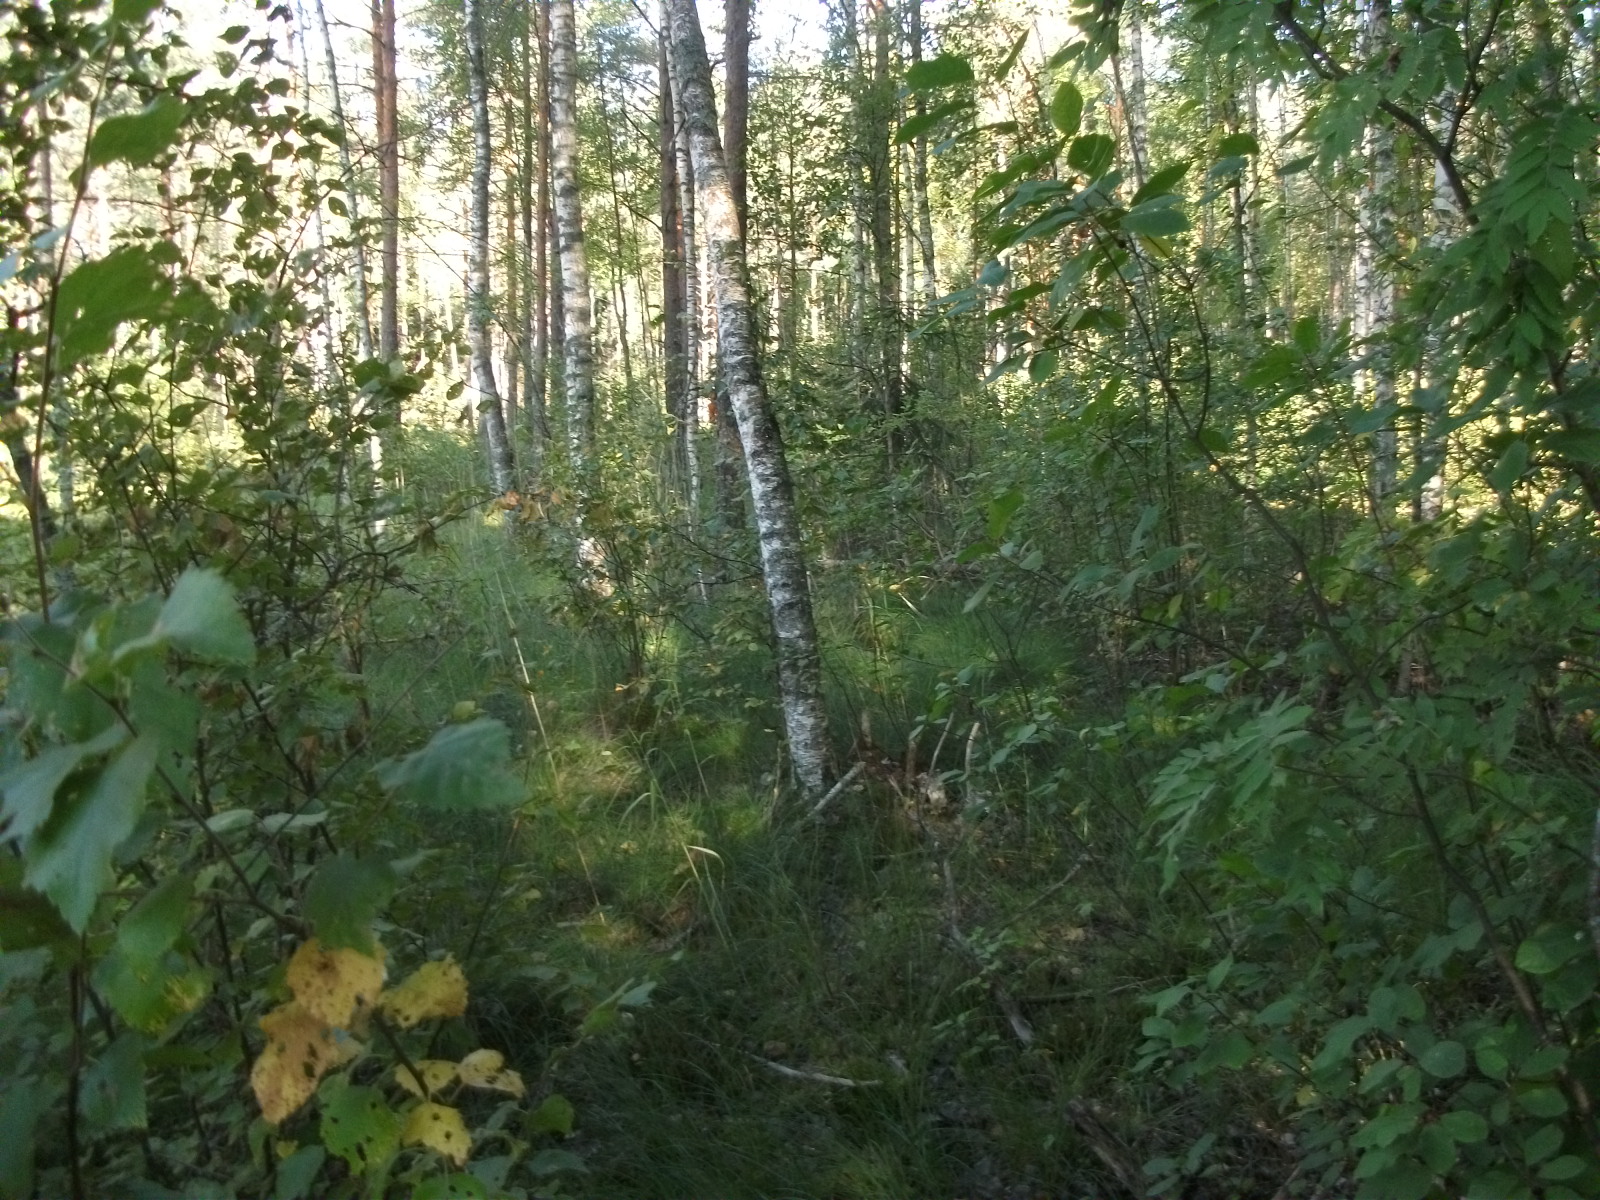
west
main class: Woodland
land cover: Broadleaved woodland
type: non-riverine alder, birch or aspen forest
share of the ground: > 75 %
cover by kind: broadleaved forest trees 85 %, shrubs 10 %, coniferous forest trees 5 %
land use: Forestry
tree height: > 5 m
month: August
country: LV
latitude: 56.2955
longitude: 26.2848
